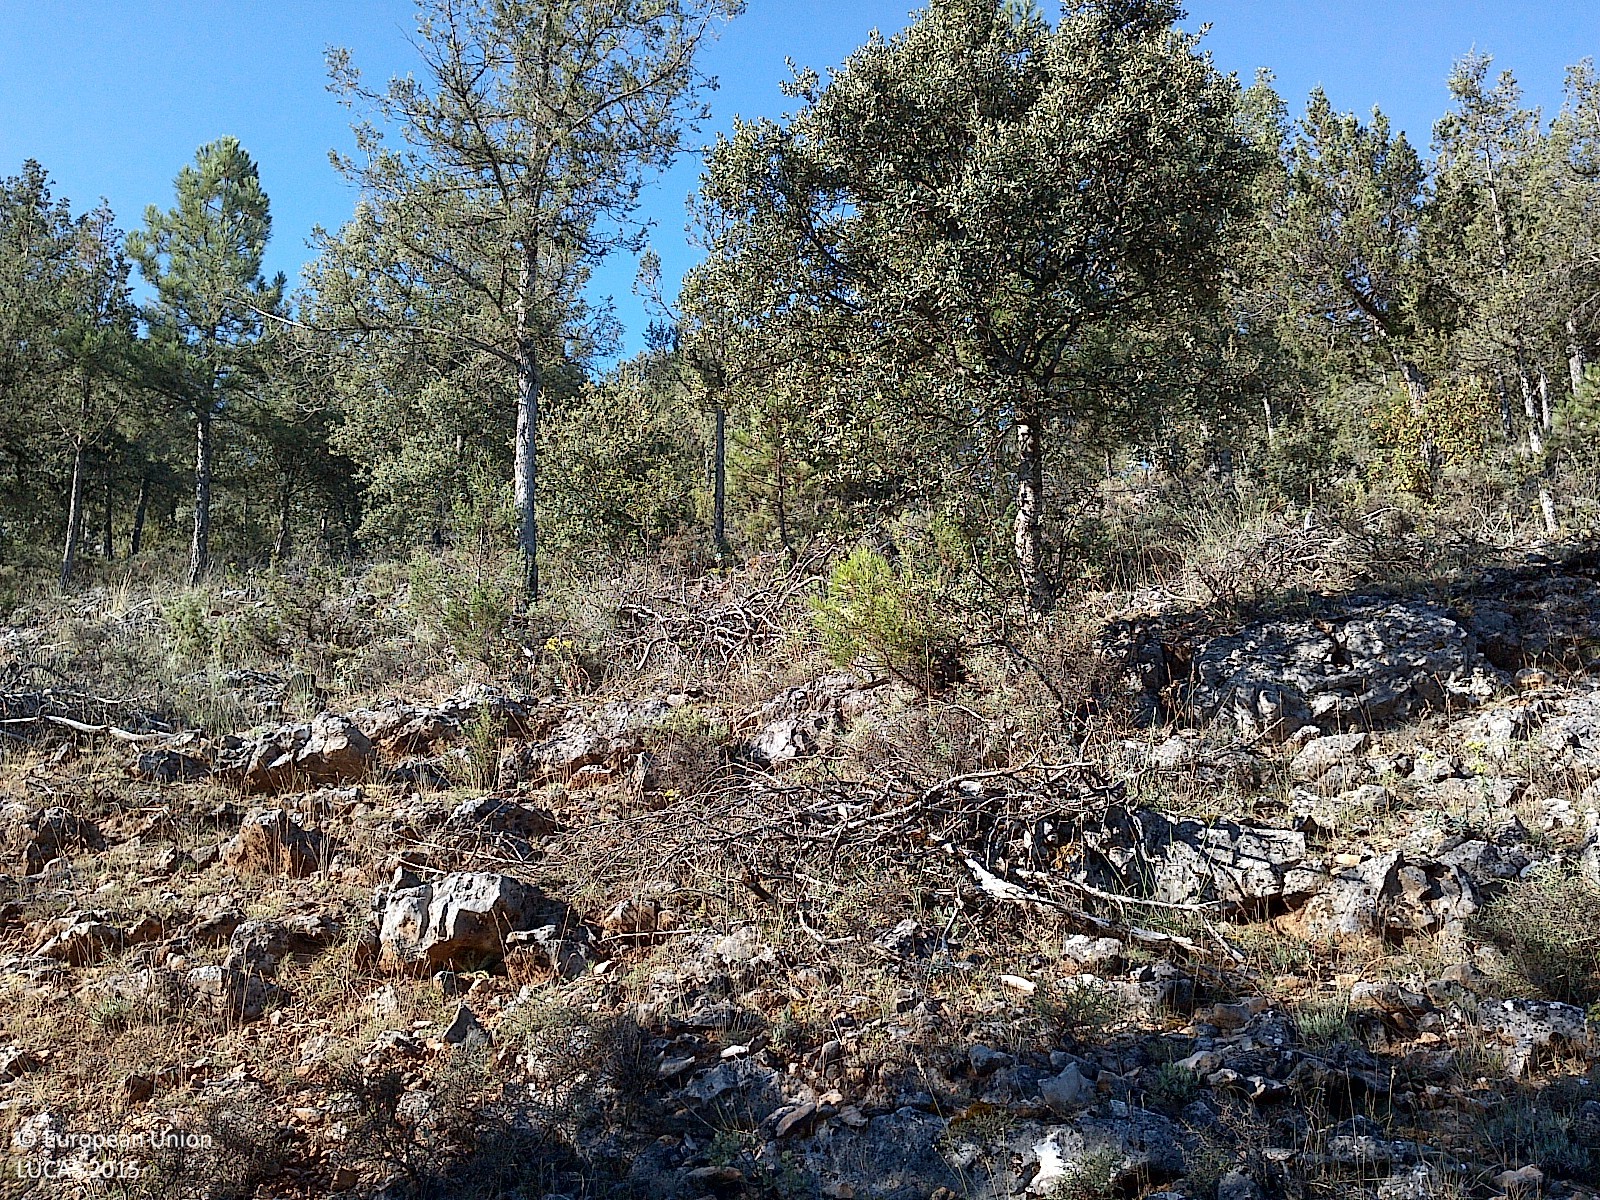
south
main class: Woodland
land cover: Other coniferous woodland
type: coniferous forest of the mediterranean region
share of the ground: 25 - 50 %
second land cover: Shrubland without tree cover
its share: 10 - 25 %
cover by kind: consolidated bare surface 30 %, coniferous forest trees 25 %, herbaceous plants 20 %, shrubs 15 %, broadleaved forest trees 5 %, unconsolidated bare surface 5 %
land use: Forestry
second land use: Agriculture (excluding fallow land and kitchen gardens)
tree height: < 5 m
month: July
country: ES
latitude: 41.8049
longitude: -3.0566
